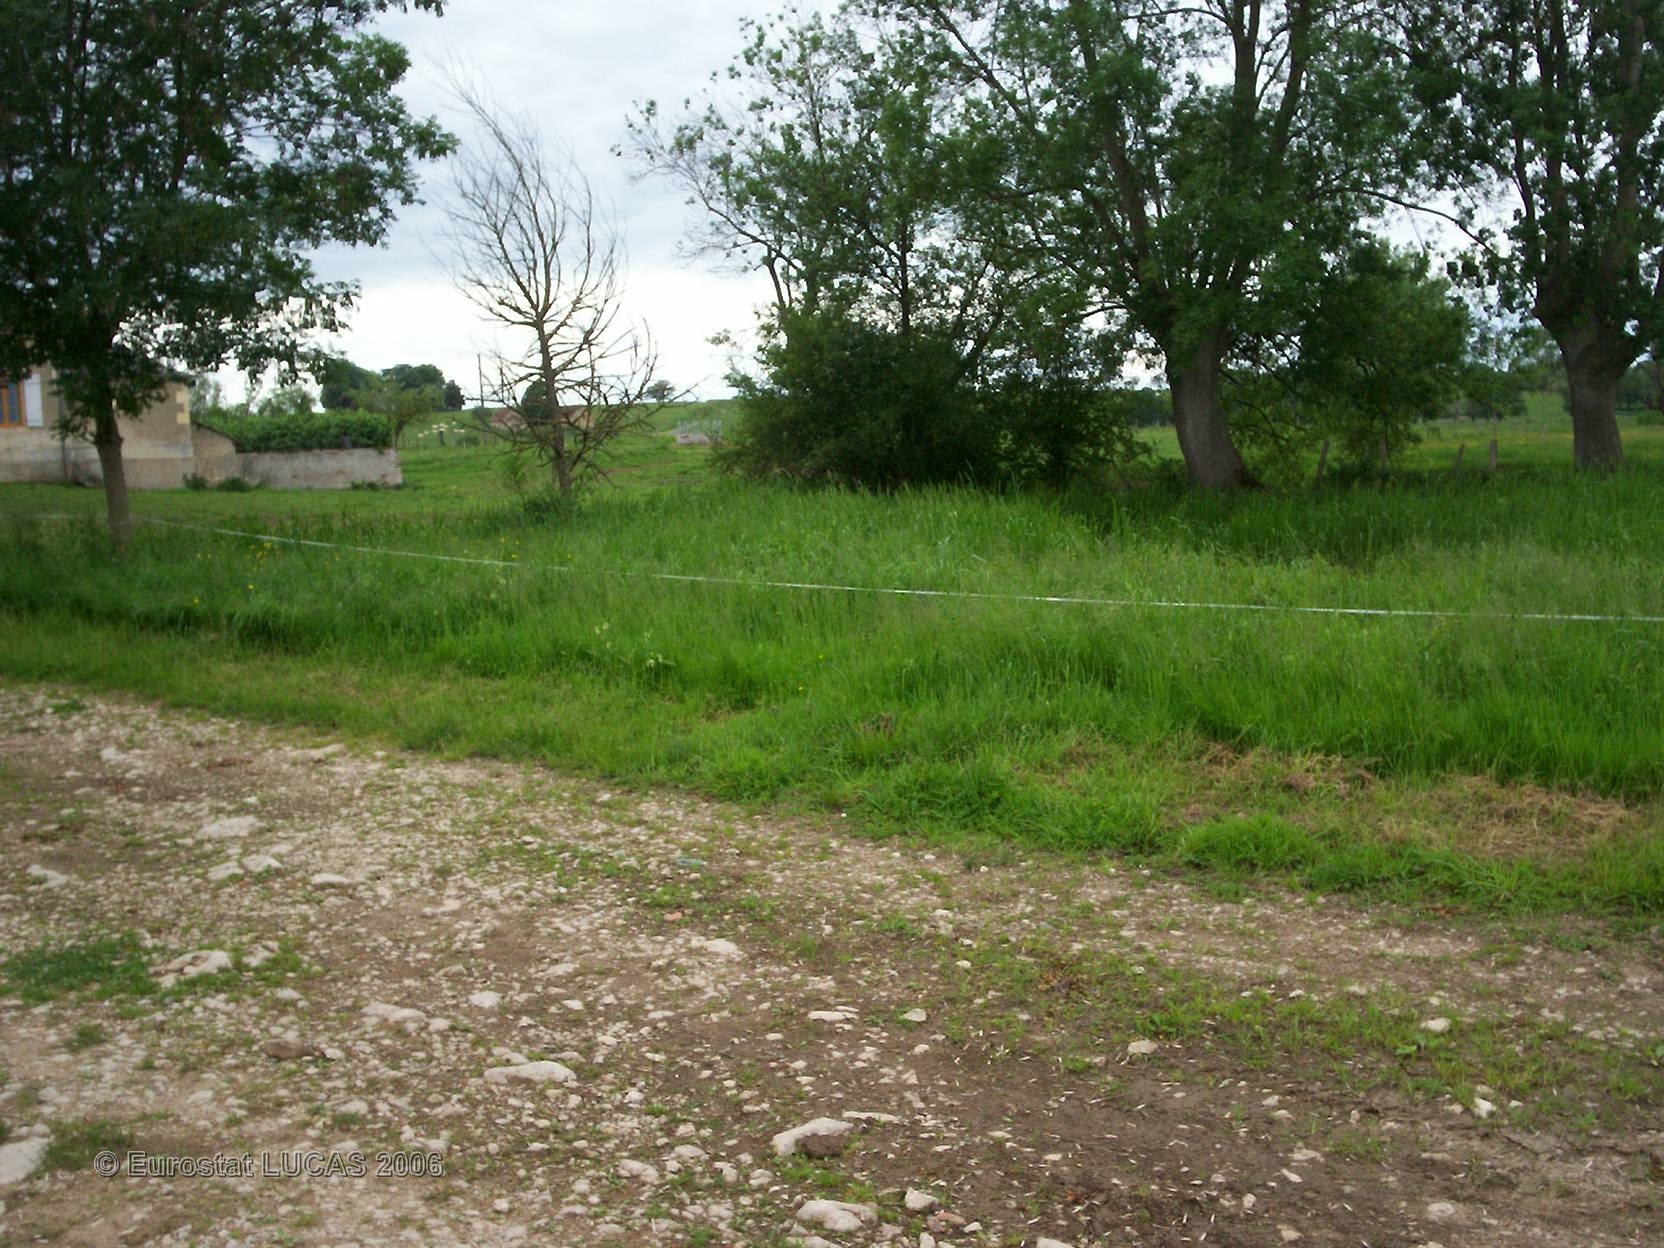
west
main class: Grassland
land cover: Grassland without tree/shrub cover
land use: Agriculture (excluding fallow land and kitchen gardens)
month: May
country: FR
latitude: 46.8664
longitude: 3.0566
